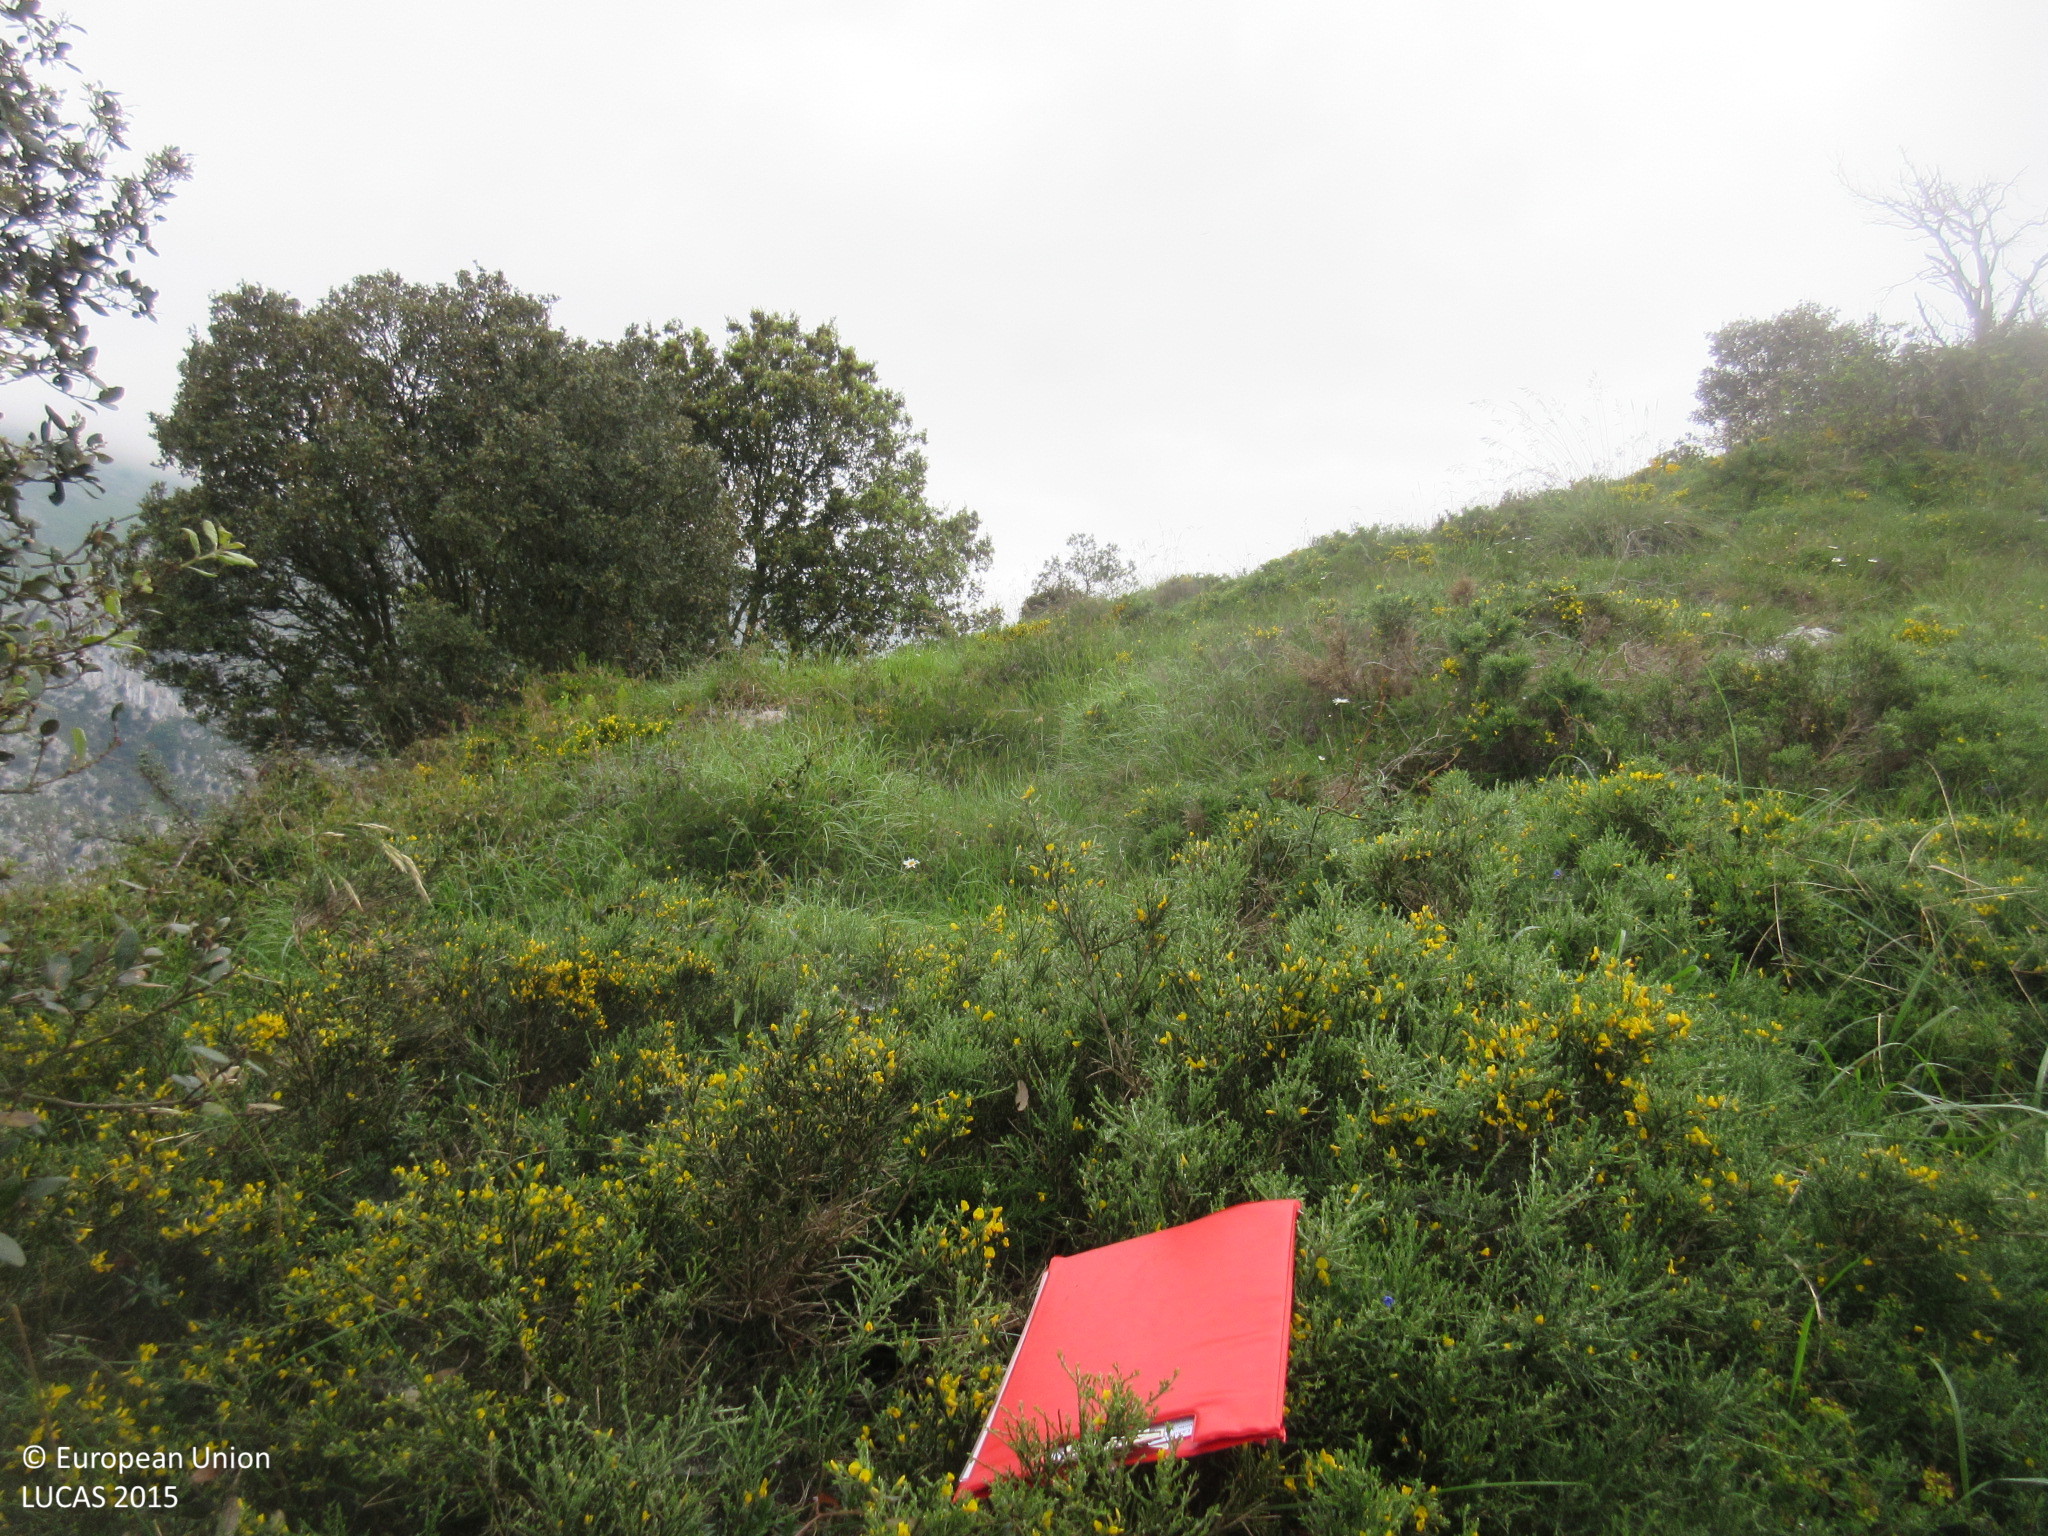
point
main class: Shrubland
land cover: Shrubland with sparse tree cover
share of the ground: > 75 %
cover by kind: shrubs 95 %, broadleaved forest trees 5 %
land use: Semi-natural and natural areas not in use
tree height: < 5 m
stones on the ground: > 50 %
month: May
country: ES
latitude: 43.3117
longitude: -4.5977
